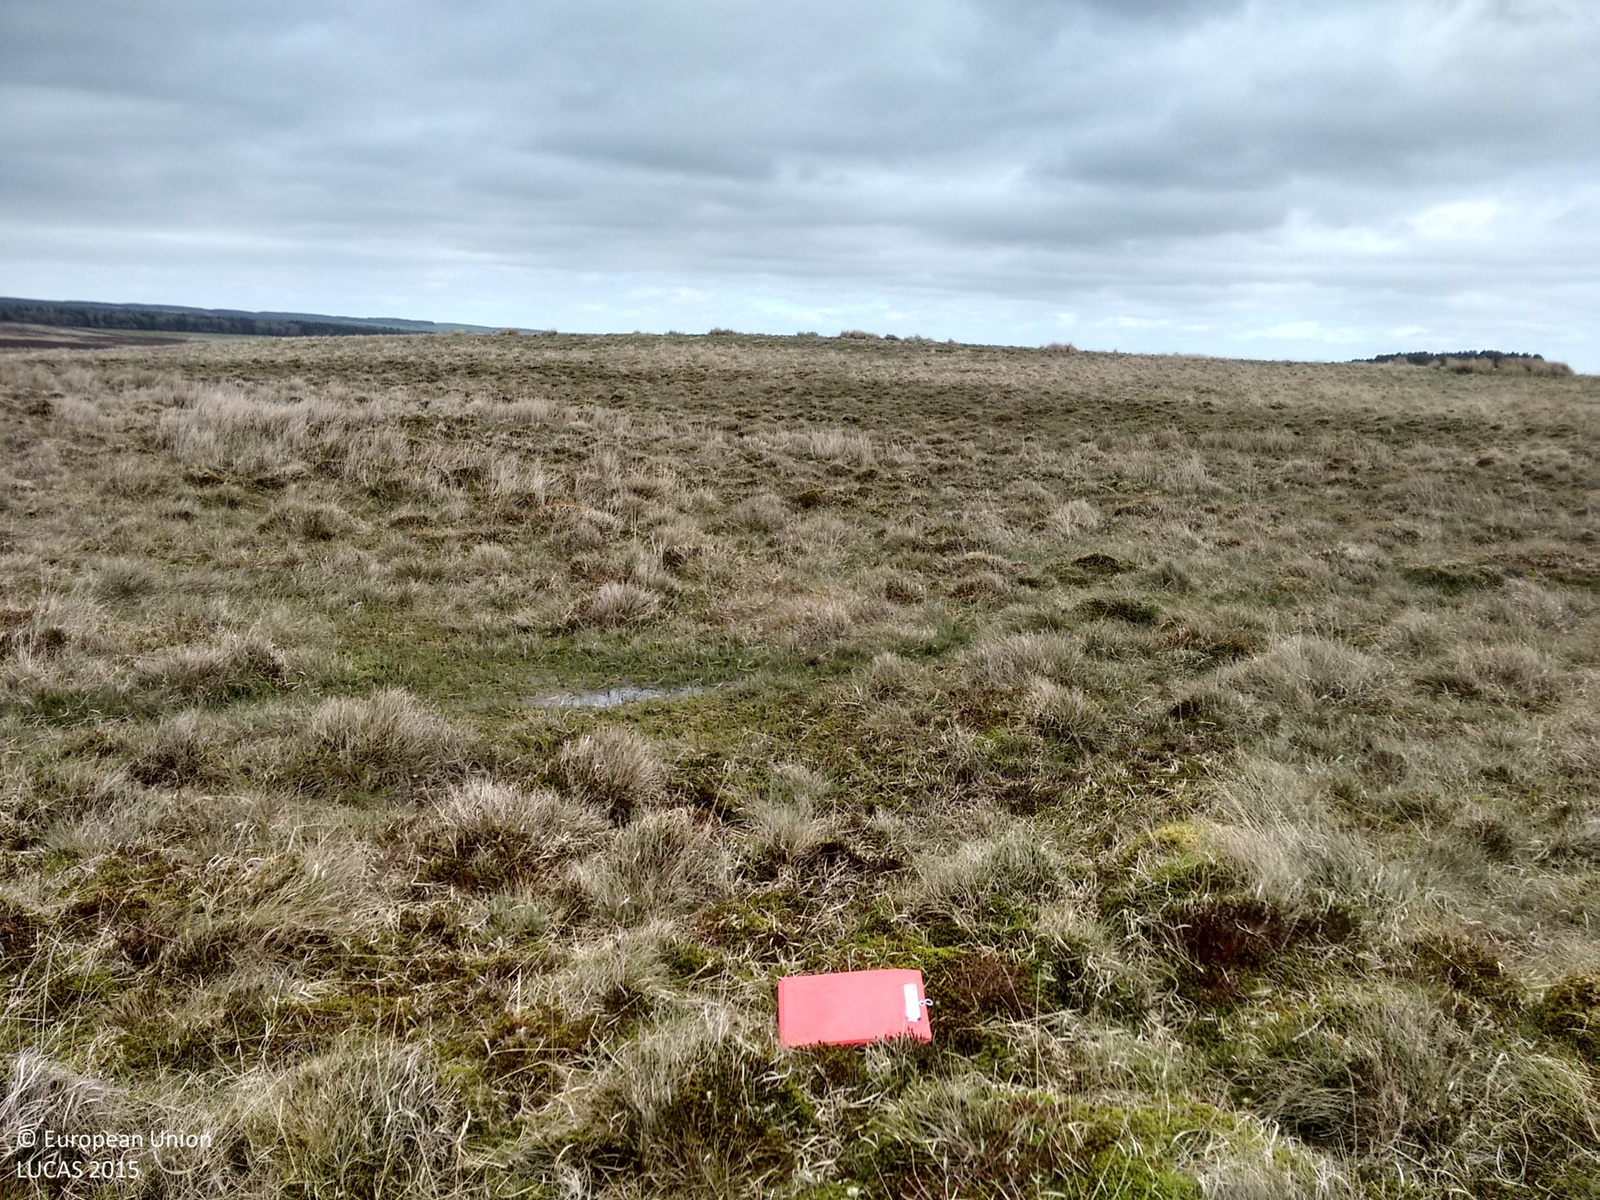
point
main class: Grassland
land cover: Grassland without tree/shrub cover
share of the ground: > 75 %
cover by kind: herbaceous plants 100 %
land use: Agriculture (excluding fallow land and kitchen gardens)
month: May
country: GB
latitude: 55.1819
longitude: -2.0369
